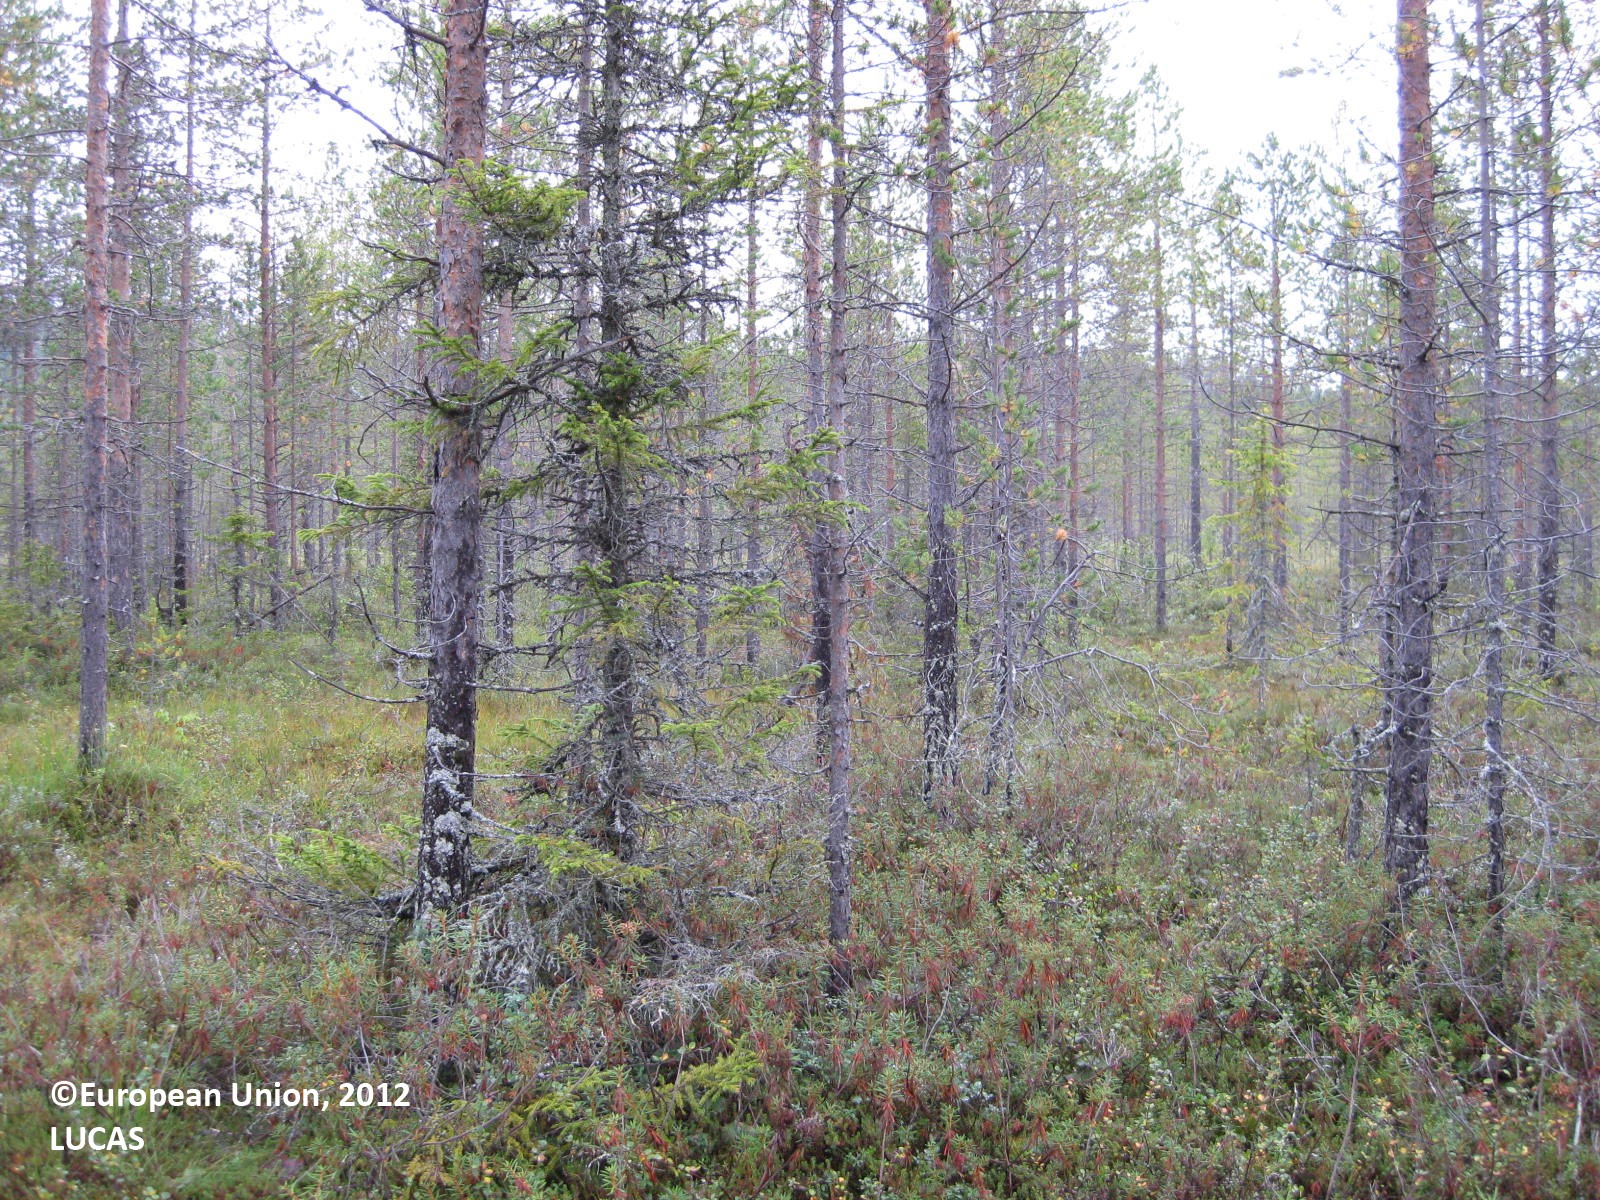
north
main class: Woodland
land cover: Pine dominated coniferous woodland
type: boreal forest
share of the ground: 50 - 75 %
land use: Forestry
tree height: > 5 m
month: August
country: FI
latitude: 66.1013
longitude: 28.8111
